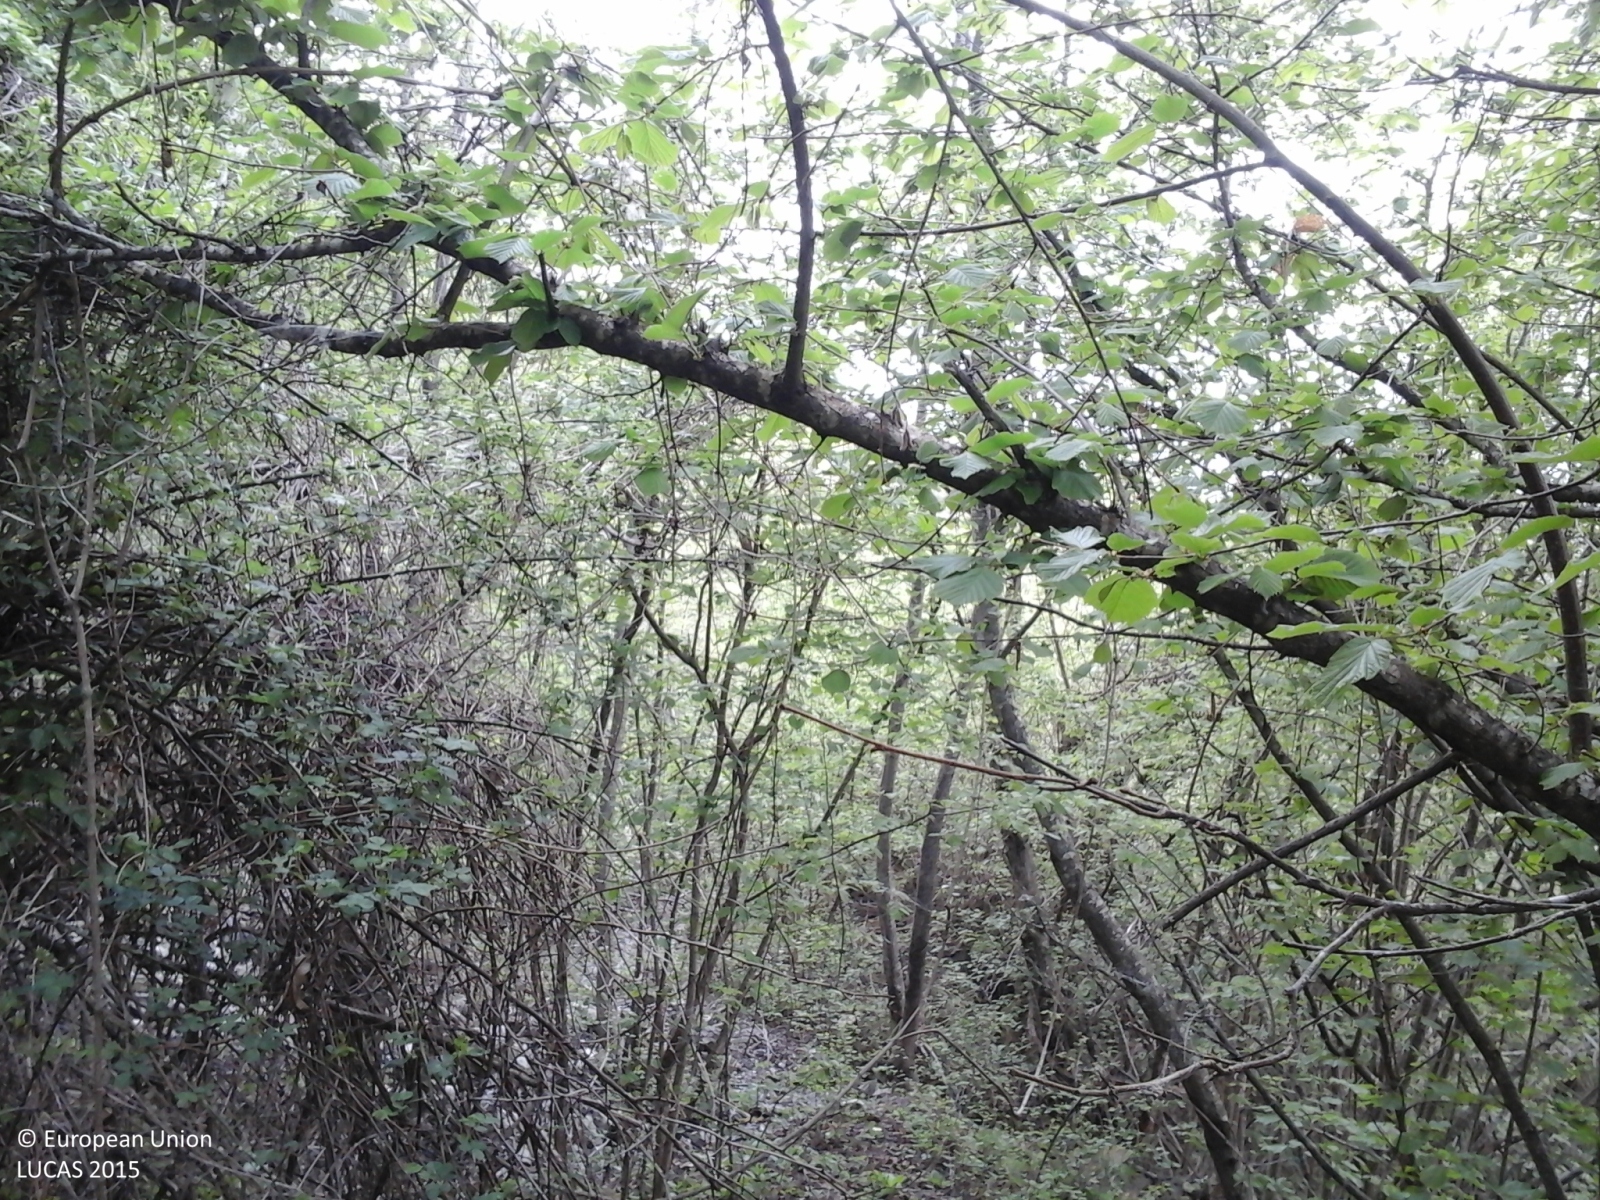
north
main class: Woodland
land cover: Broadleaved woodland
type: mesophytic deciduous forest
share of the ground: > 75 %
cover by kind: broadleaved forest trees 70 %, shrubs 30 %
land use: Forestry
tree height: > 5 m
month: May
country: IT
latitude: 44.6373
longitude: 9.3836
